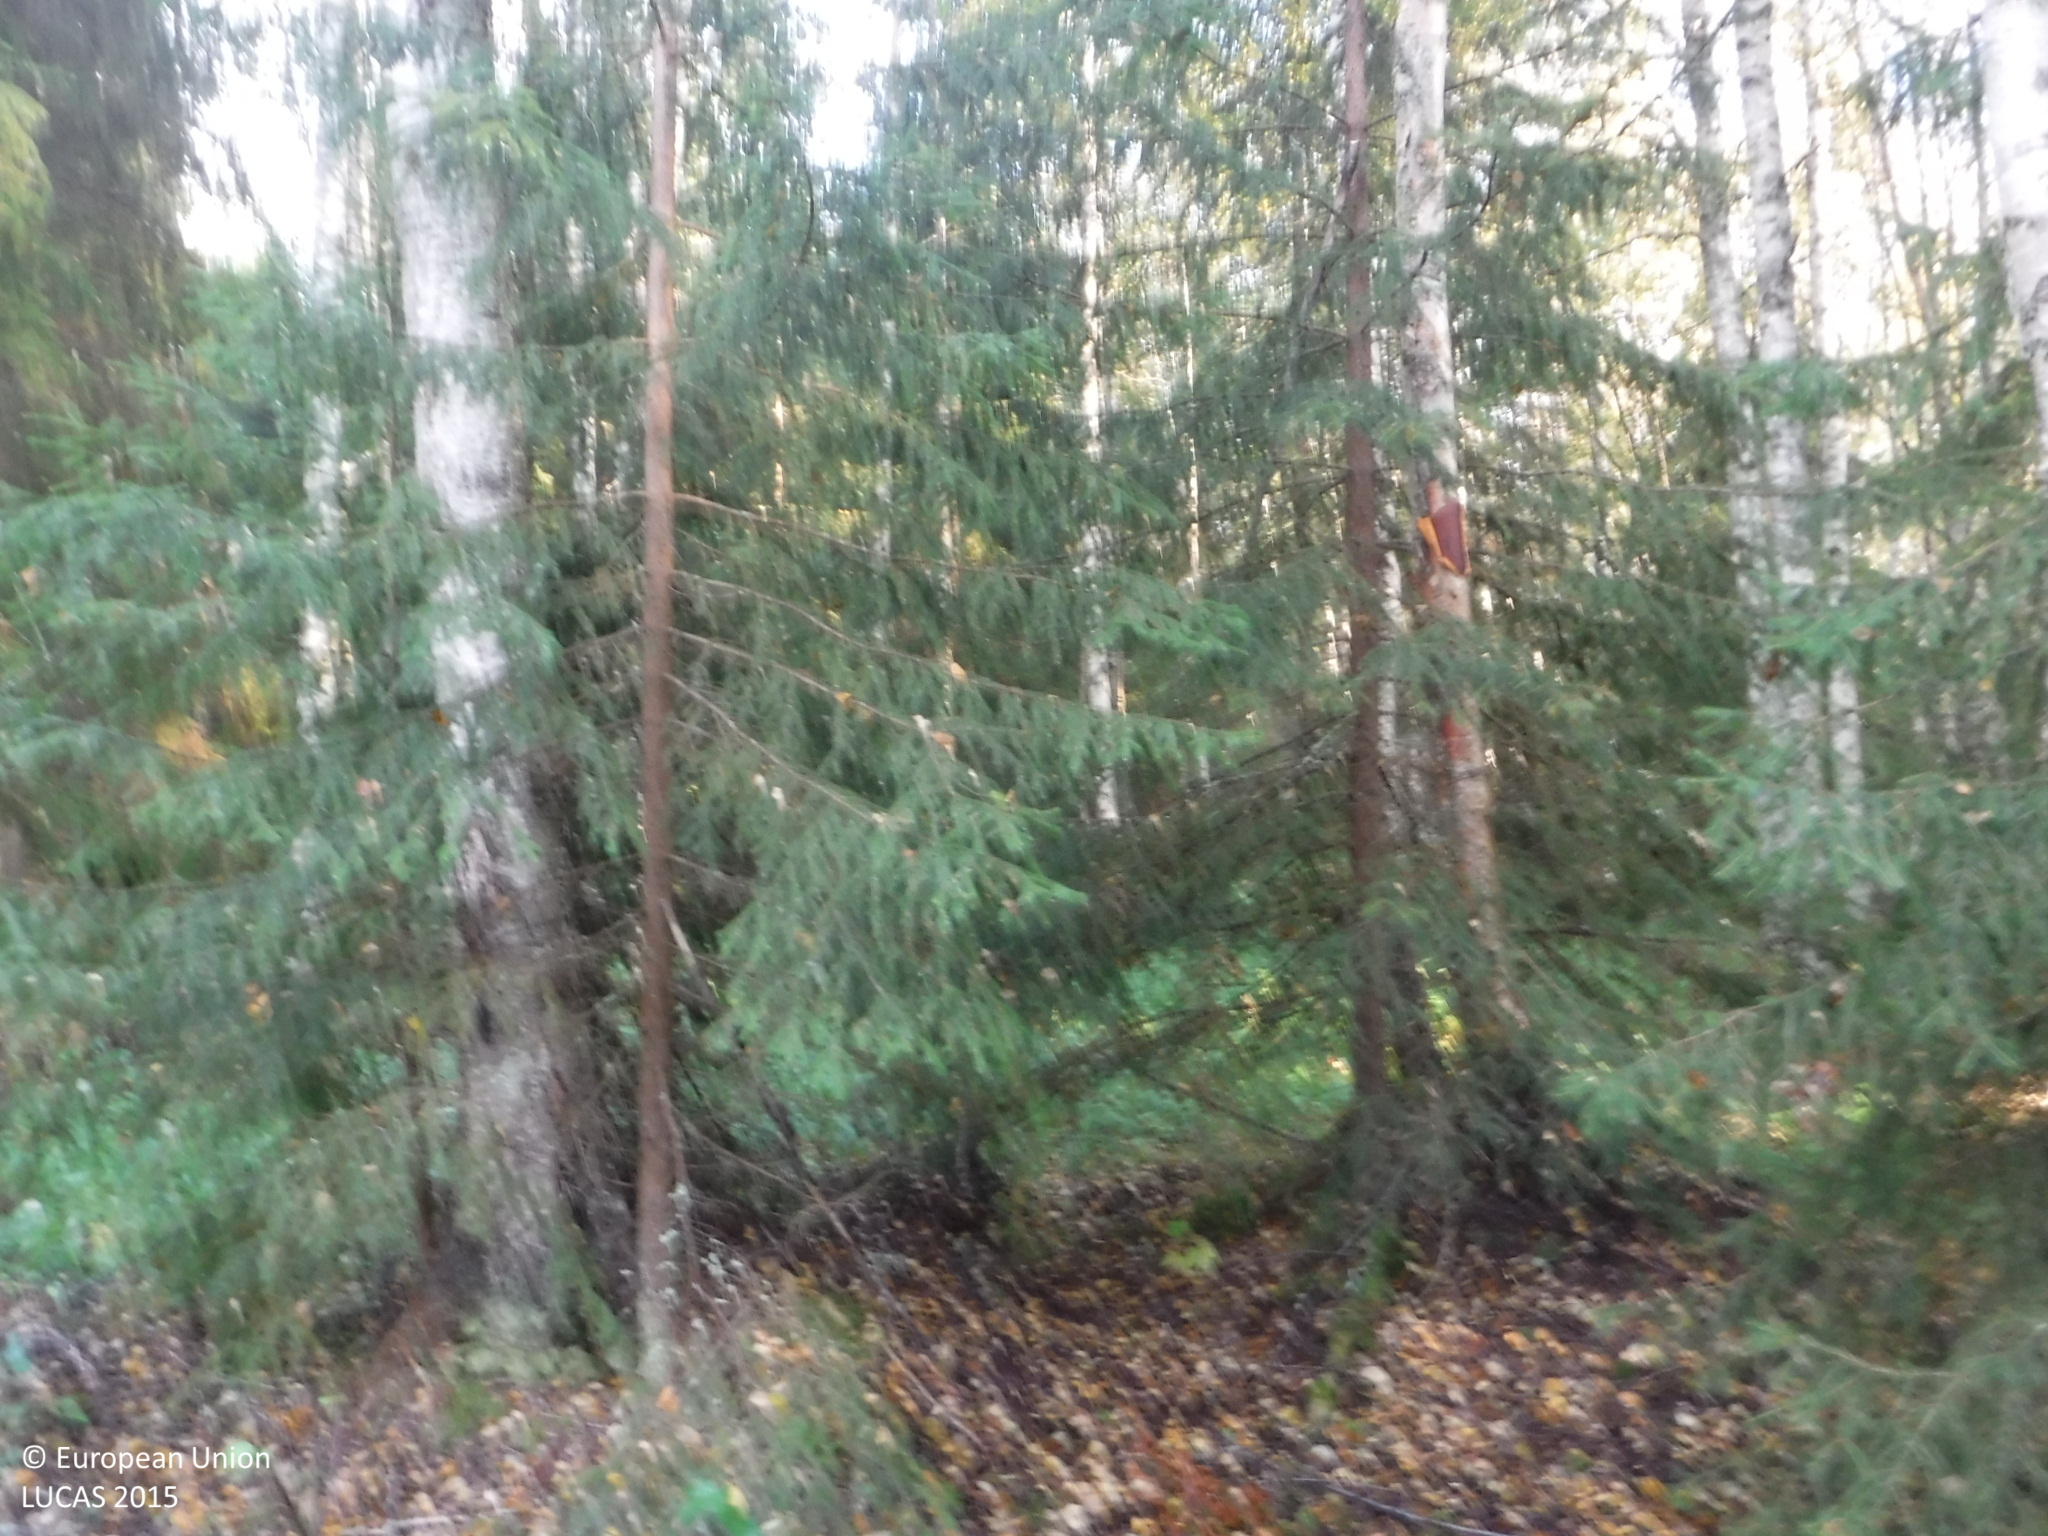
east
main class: Woodland
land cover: Spruce dominated mixed woodland
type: boreal forest
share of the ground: 50 - 75 %
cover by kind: coniferous forest trees 35 %, herbaceous plants 35 %, broadleaved forest trees 20 %, shrubs 10 %
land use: Forestry
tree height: > 5 m
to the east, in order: Spruce dominated mixed woodland; Other mixed woodland; Pine dominated mixed woodland; Pine dominated coniferous woodland
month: September
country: FI
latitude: 61.7205
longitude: 21.6491
